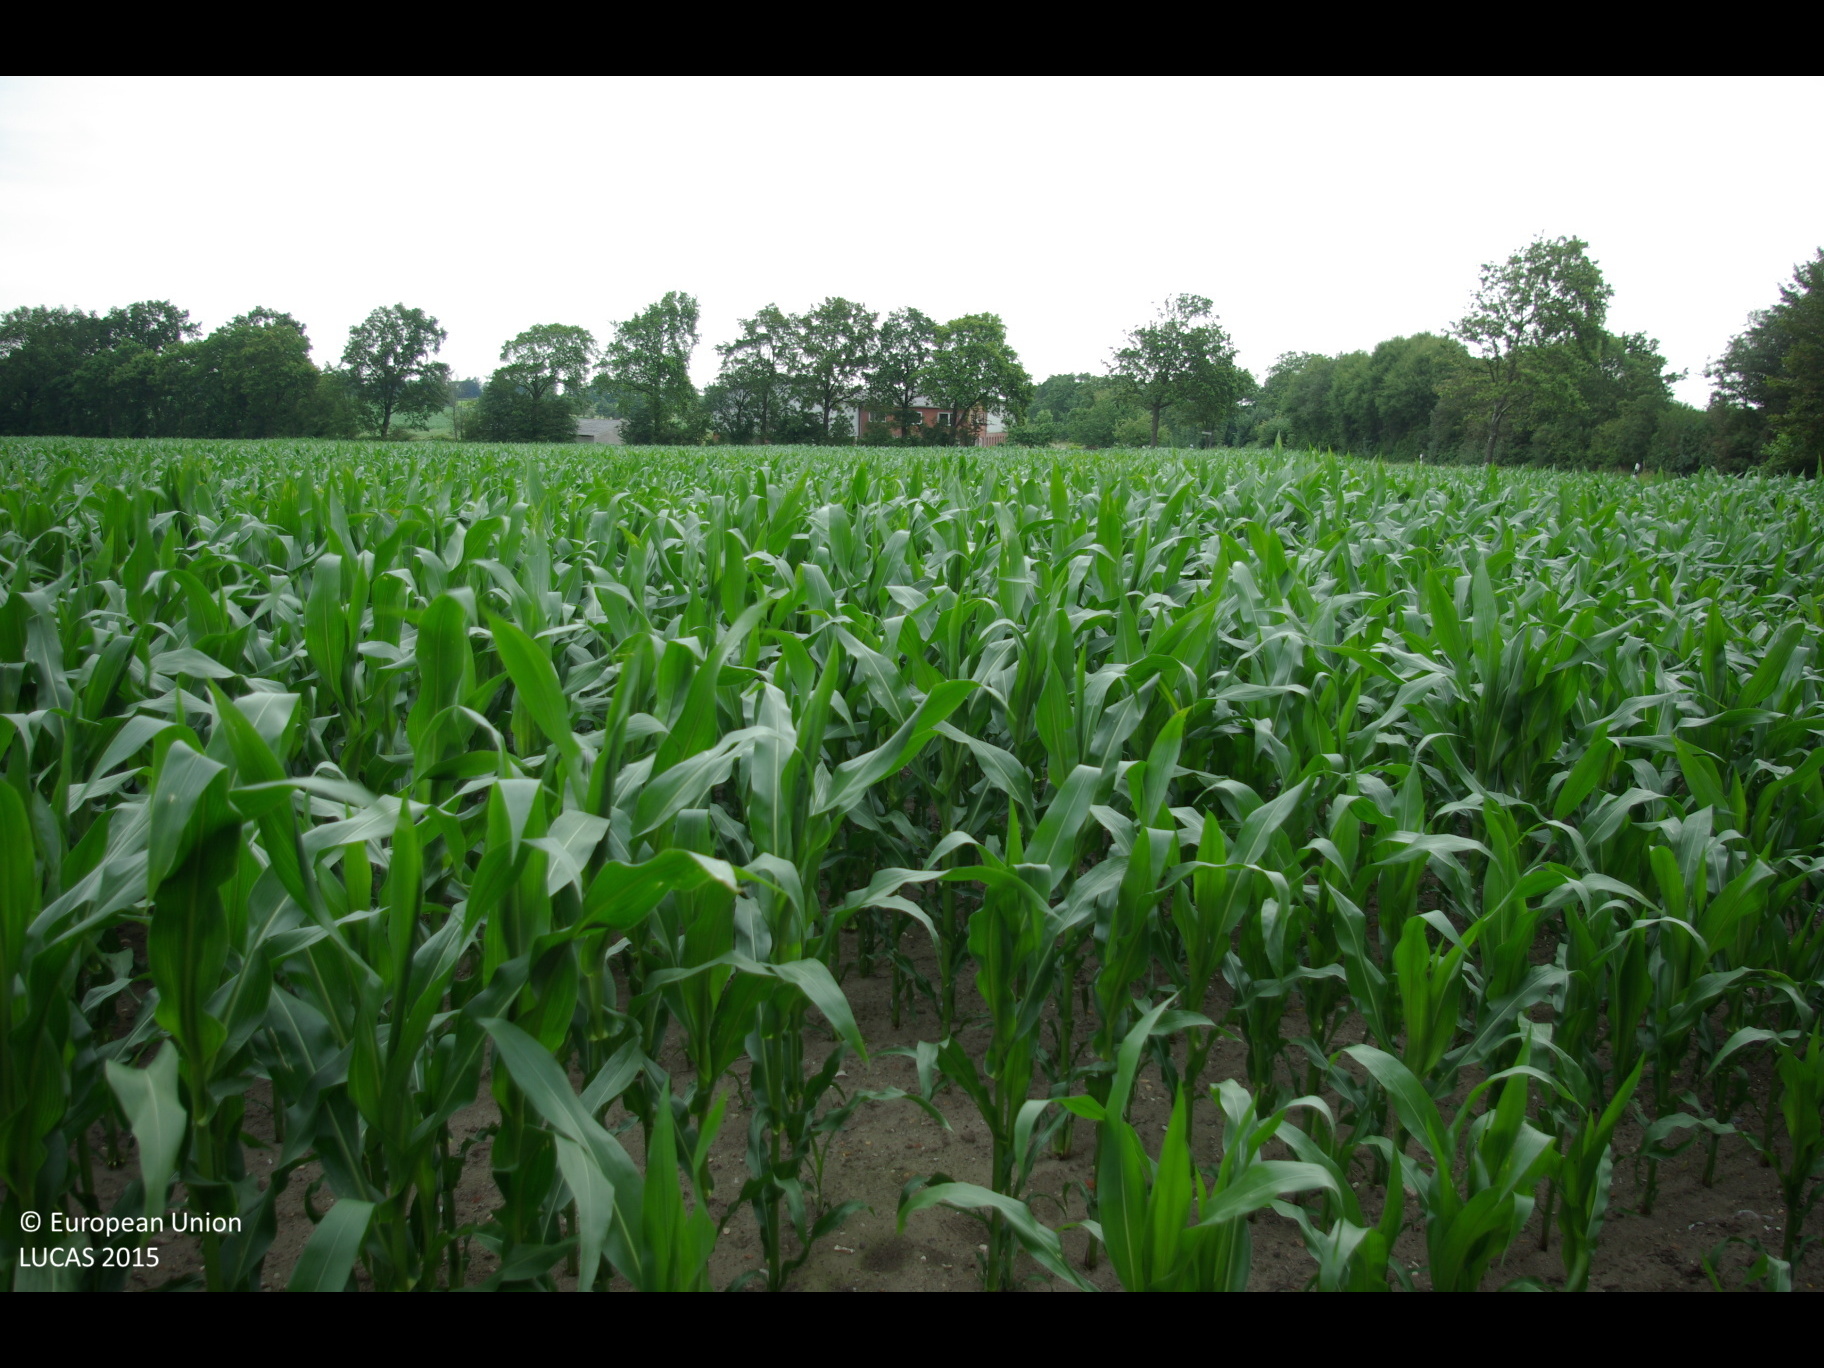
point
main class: Cropland
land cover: Maize
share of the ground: > 75 %
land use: Agriculture (excluding fallow land and kitchen gardens)
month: July
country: DE
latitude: 54.1728
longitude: 9.3111
